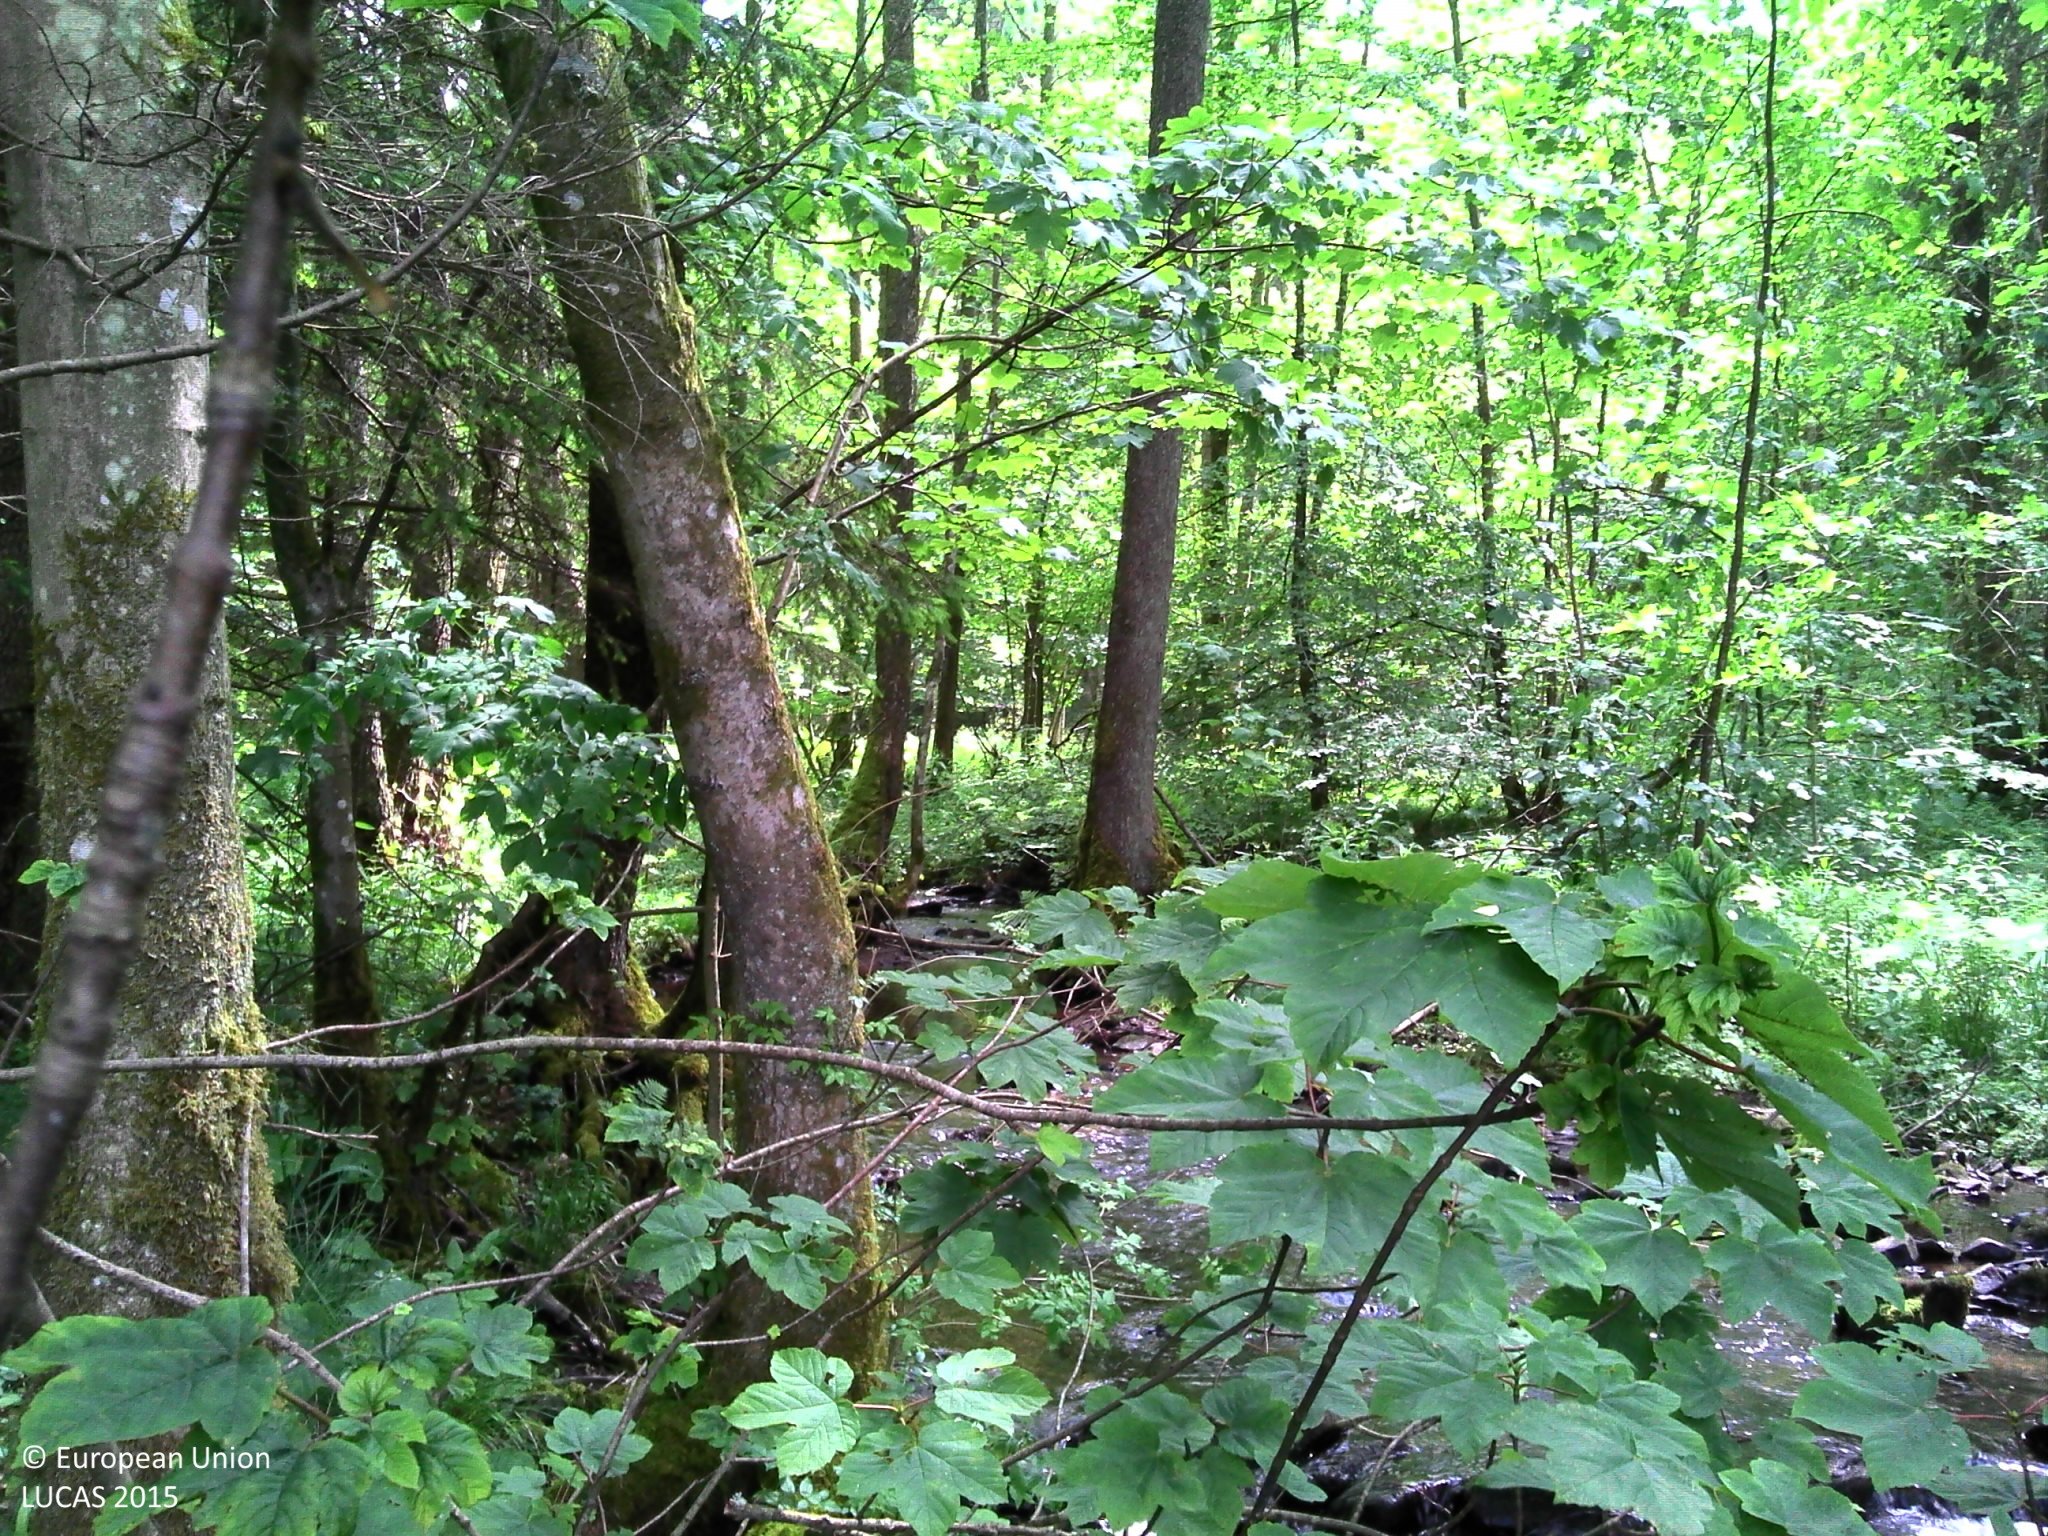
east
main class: Woodland
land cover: Broadleaved woodland
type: floodplain forest
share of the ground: > 75 %
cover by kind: broadleaved forest trees 85 %, coniferous forest trees 10 %, herbaceous plants 5 %
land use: Forestry
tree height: > 5 m
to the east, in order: Broadleaved woodland; Rivers and streams; Broadleaved woodland; Spruce dominated coniferous woodland; Broadleaved woodland; Rivers and streams; Broadleaved woodland; Grass margins; Railways; Grass margins; Broadleaved woodland
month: June
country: BE
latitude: 50.2438
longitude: 5.6094
